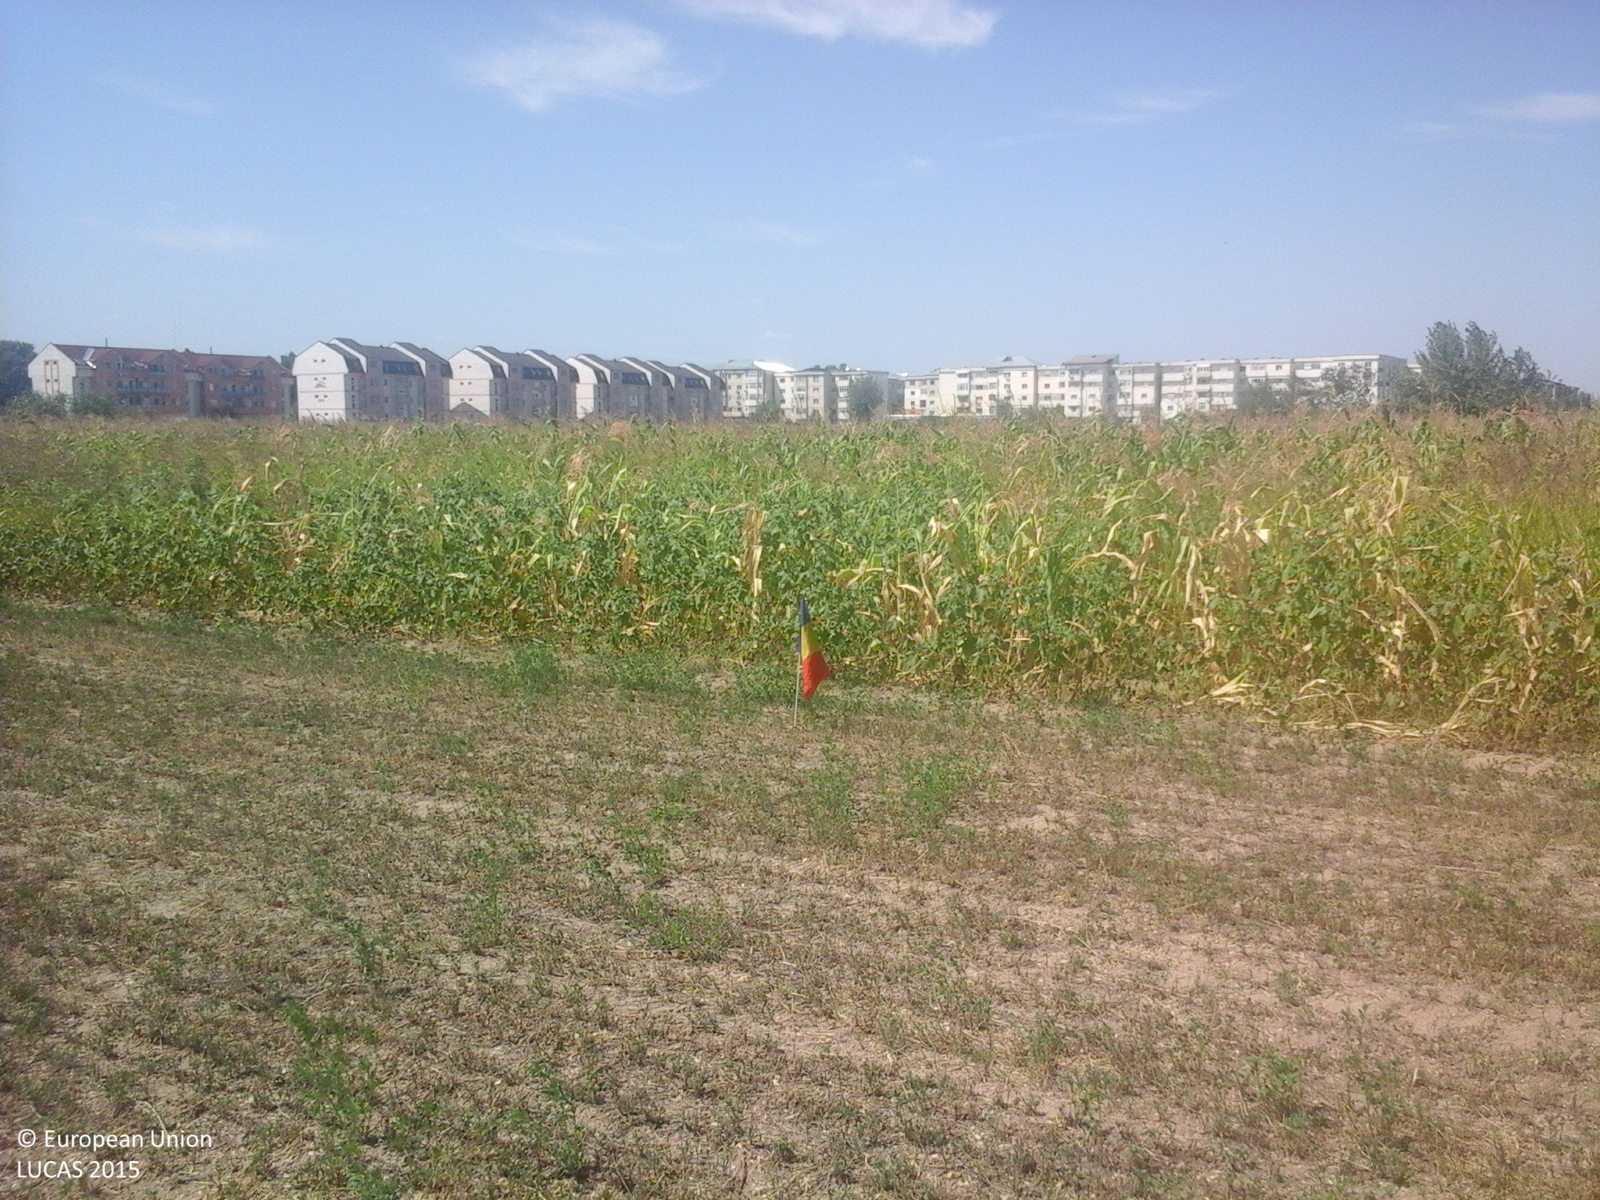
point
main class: Cropland
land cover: Lucerne
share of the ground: 50 - 75 %
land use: Agriculture (excluding fallow land and kitchen gardens)
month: August
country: RO
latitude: 45.8244
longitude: 27.4417
